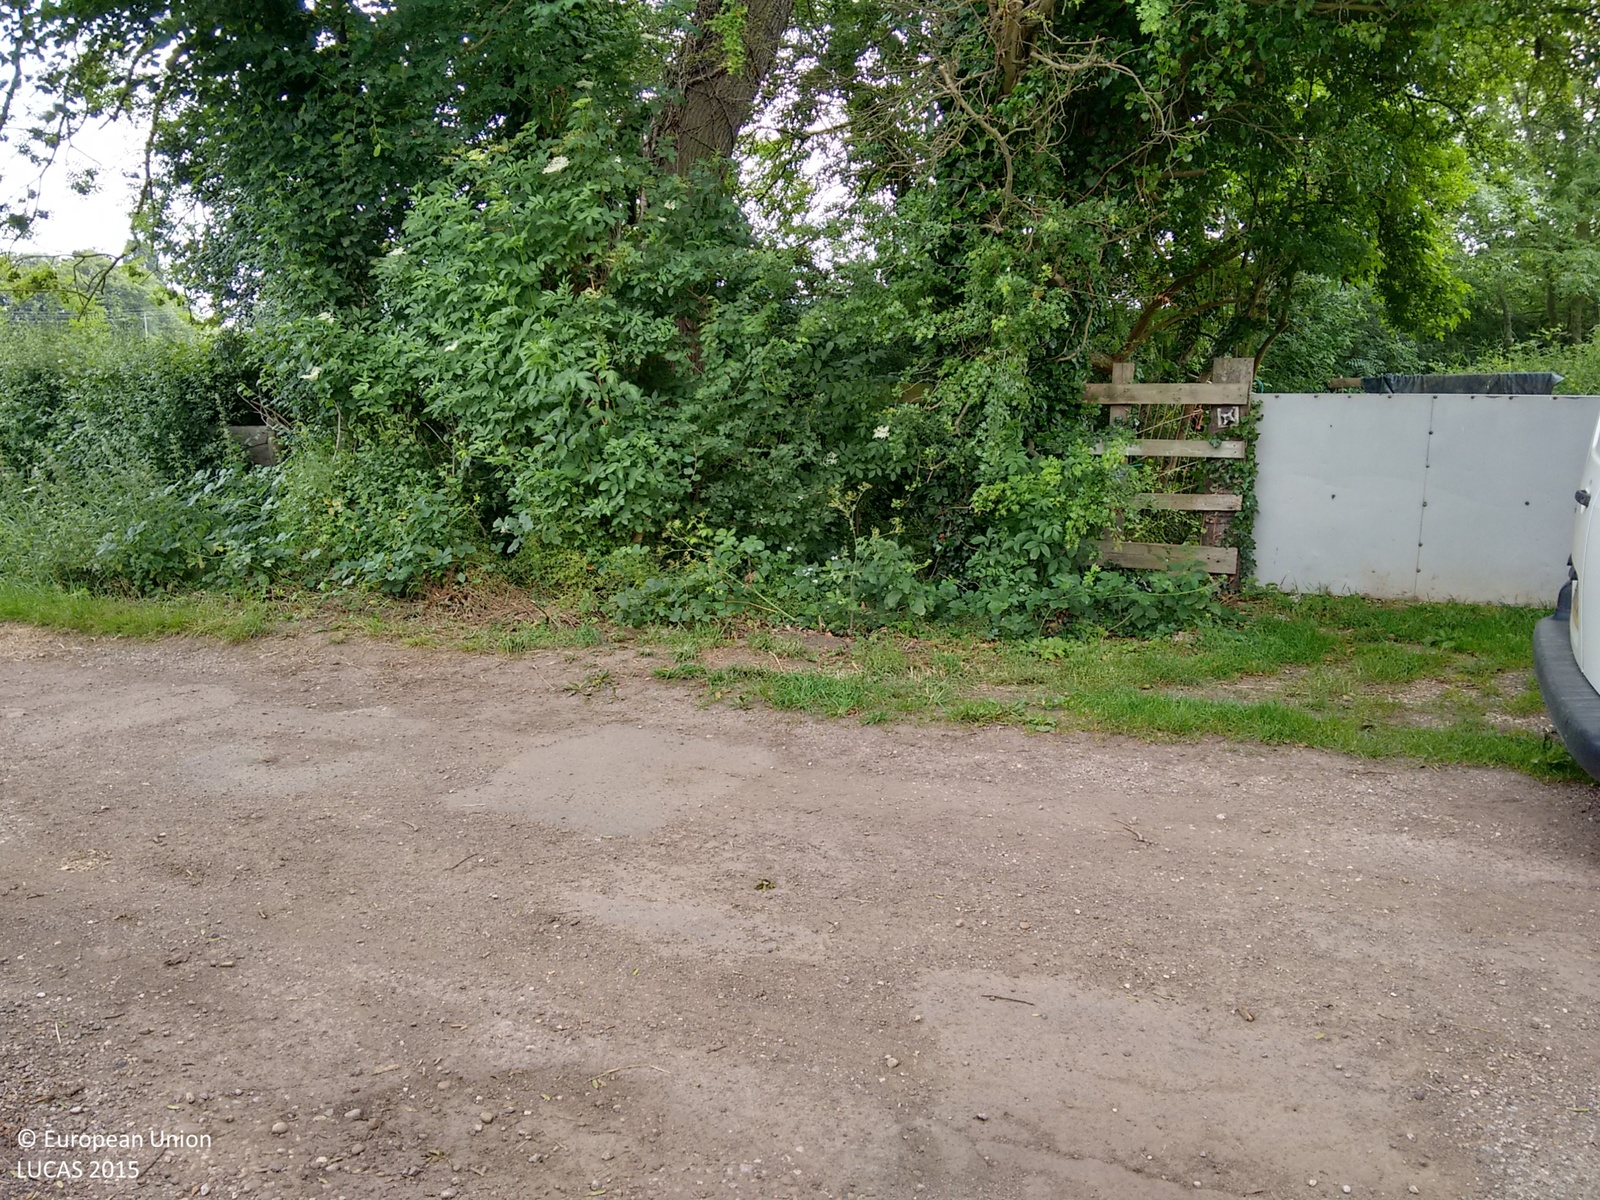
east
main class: Grassland
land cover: Grassland without tree/shrub cover
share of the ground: > 75 %
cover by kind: herbaceous plants 100 %
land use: Agriculture (excluding fallow land and kitchen gardens)
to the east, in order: Grassland without tree/shrub cover; Single bushes/trees; Managed hedges; Electric lines; Grass margins; Paved roads, cycling and walking lanes; Grass margins; Managed hedges; Electric lines; Grassland without tree/shrub cover; Managed hedges; Grassland without tree/shrub cover; Electric lines; Grassland without tree/shrub cover; Managed hedges; Grassland without tree/shrub cover
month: June
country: GB
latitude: 53.0110
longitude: -0.9683
